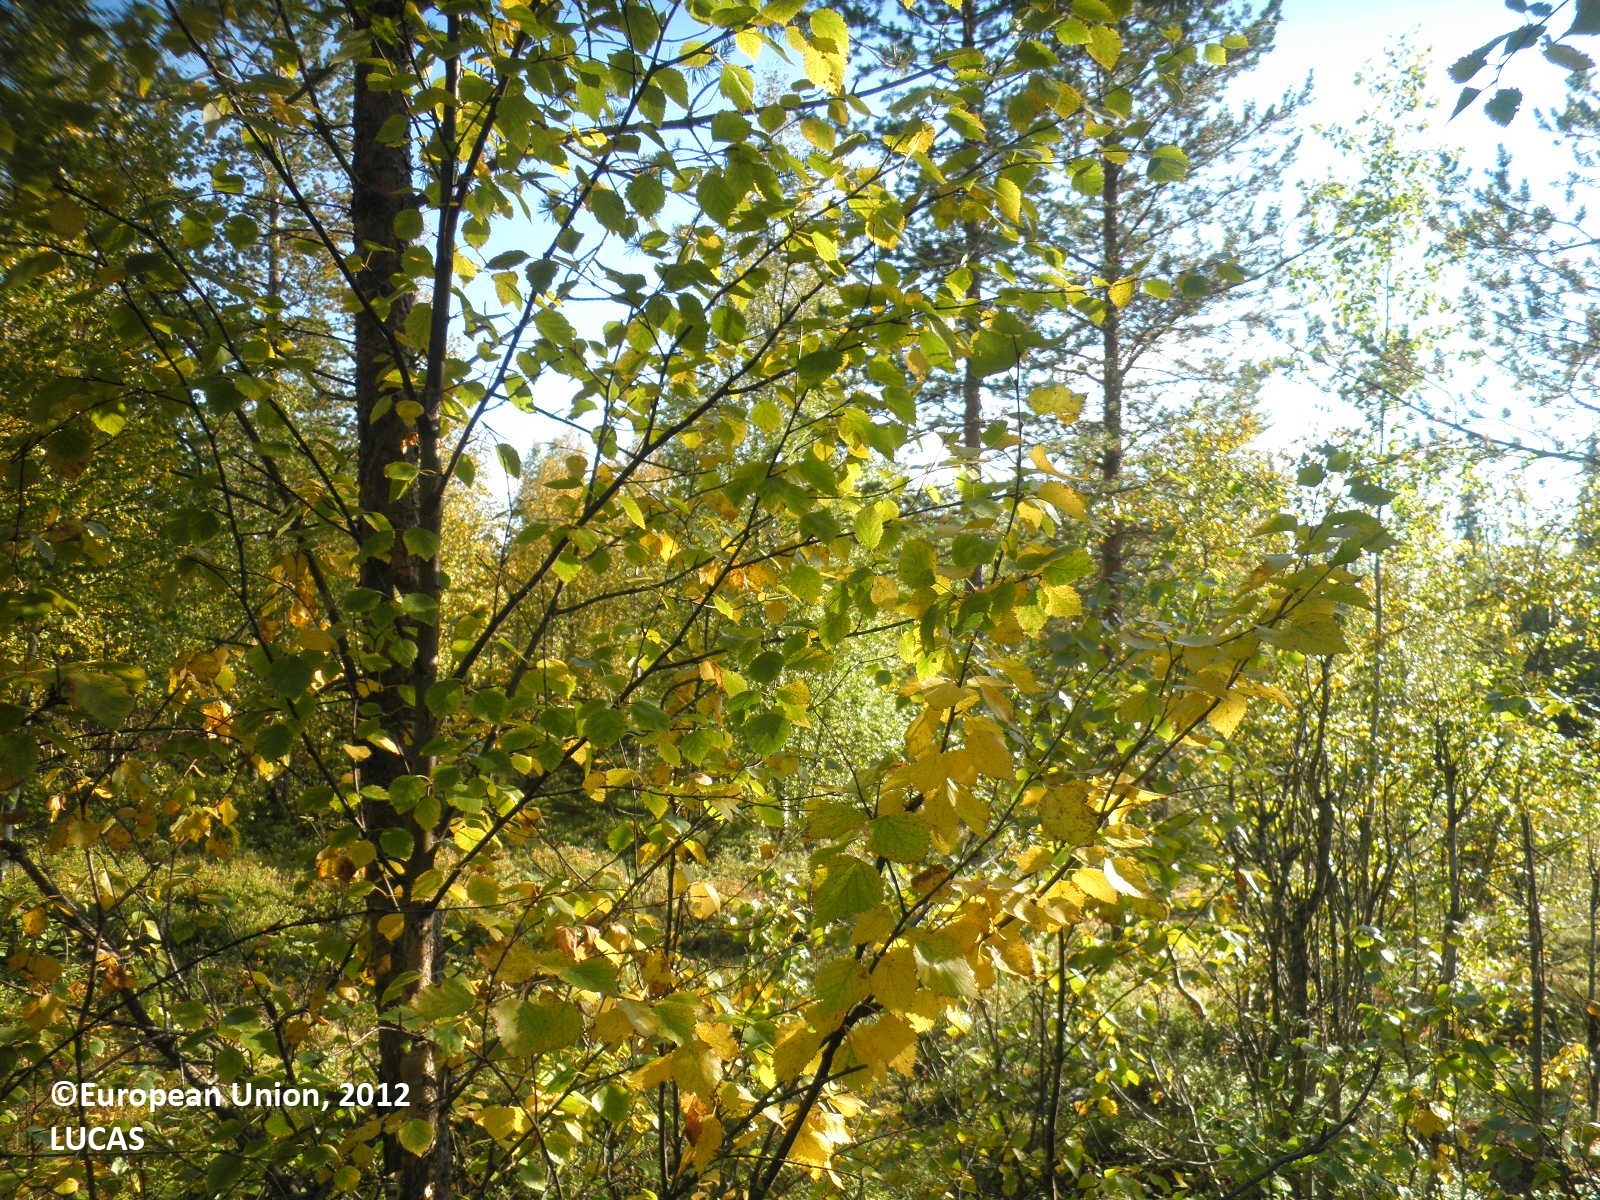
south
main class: Woodland
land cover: Pine dominated mixed woodland
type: boreal forest
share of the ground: 50 - 75 %
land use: Forestry
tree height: > 5 m
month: August
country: FI
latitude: 67.6957
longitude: 27.2041
